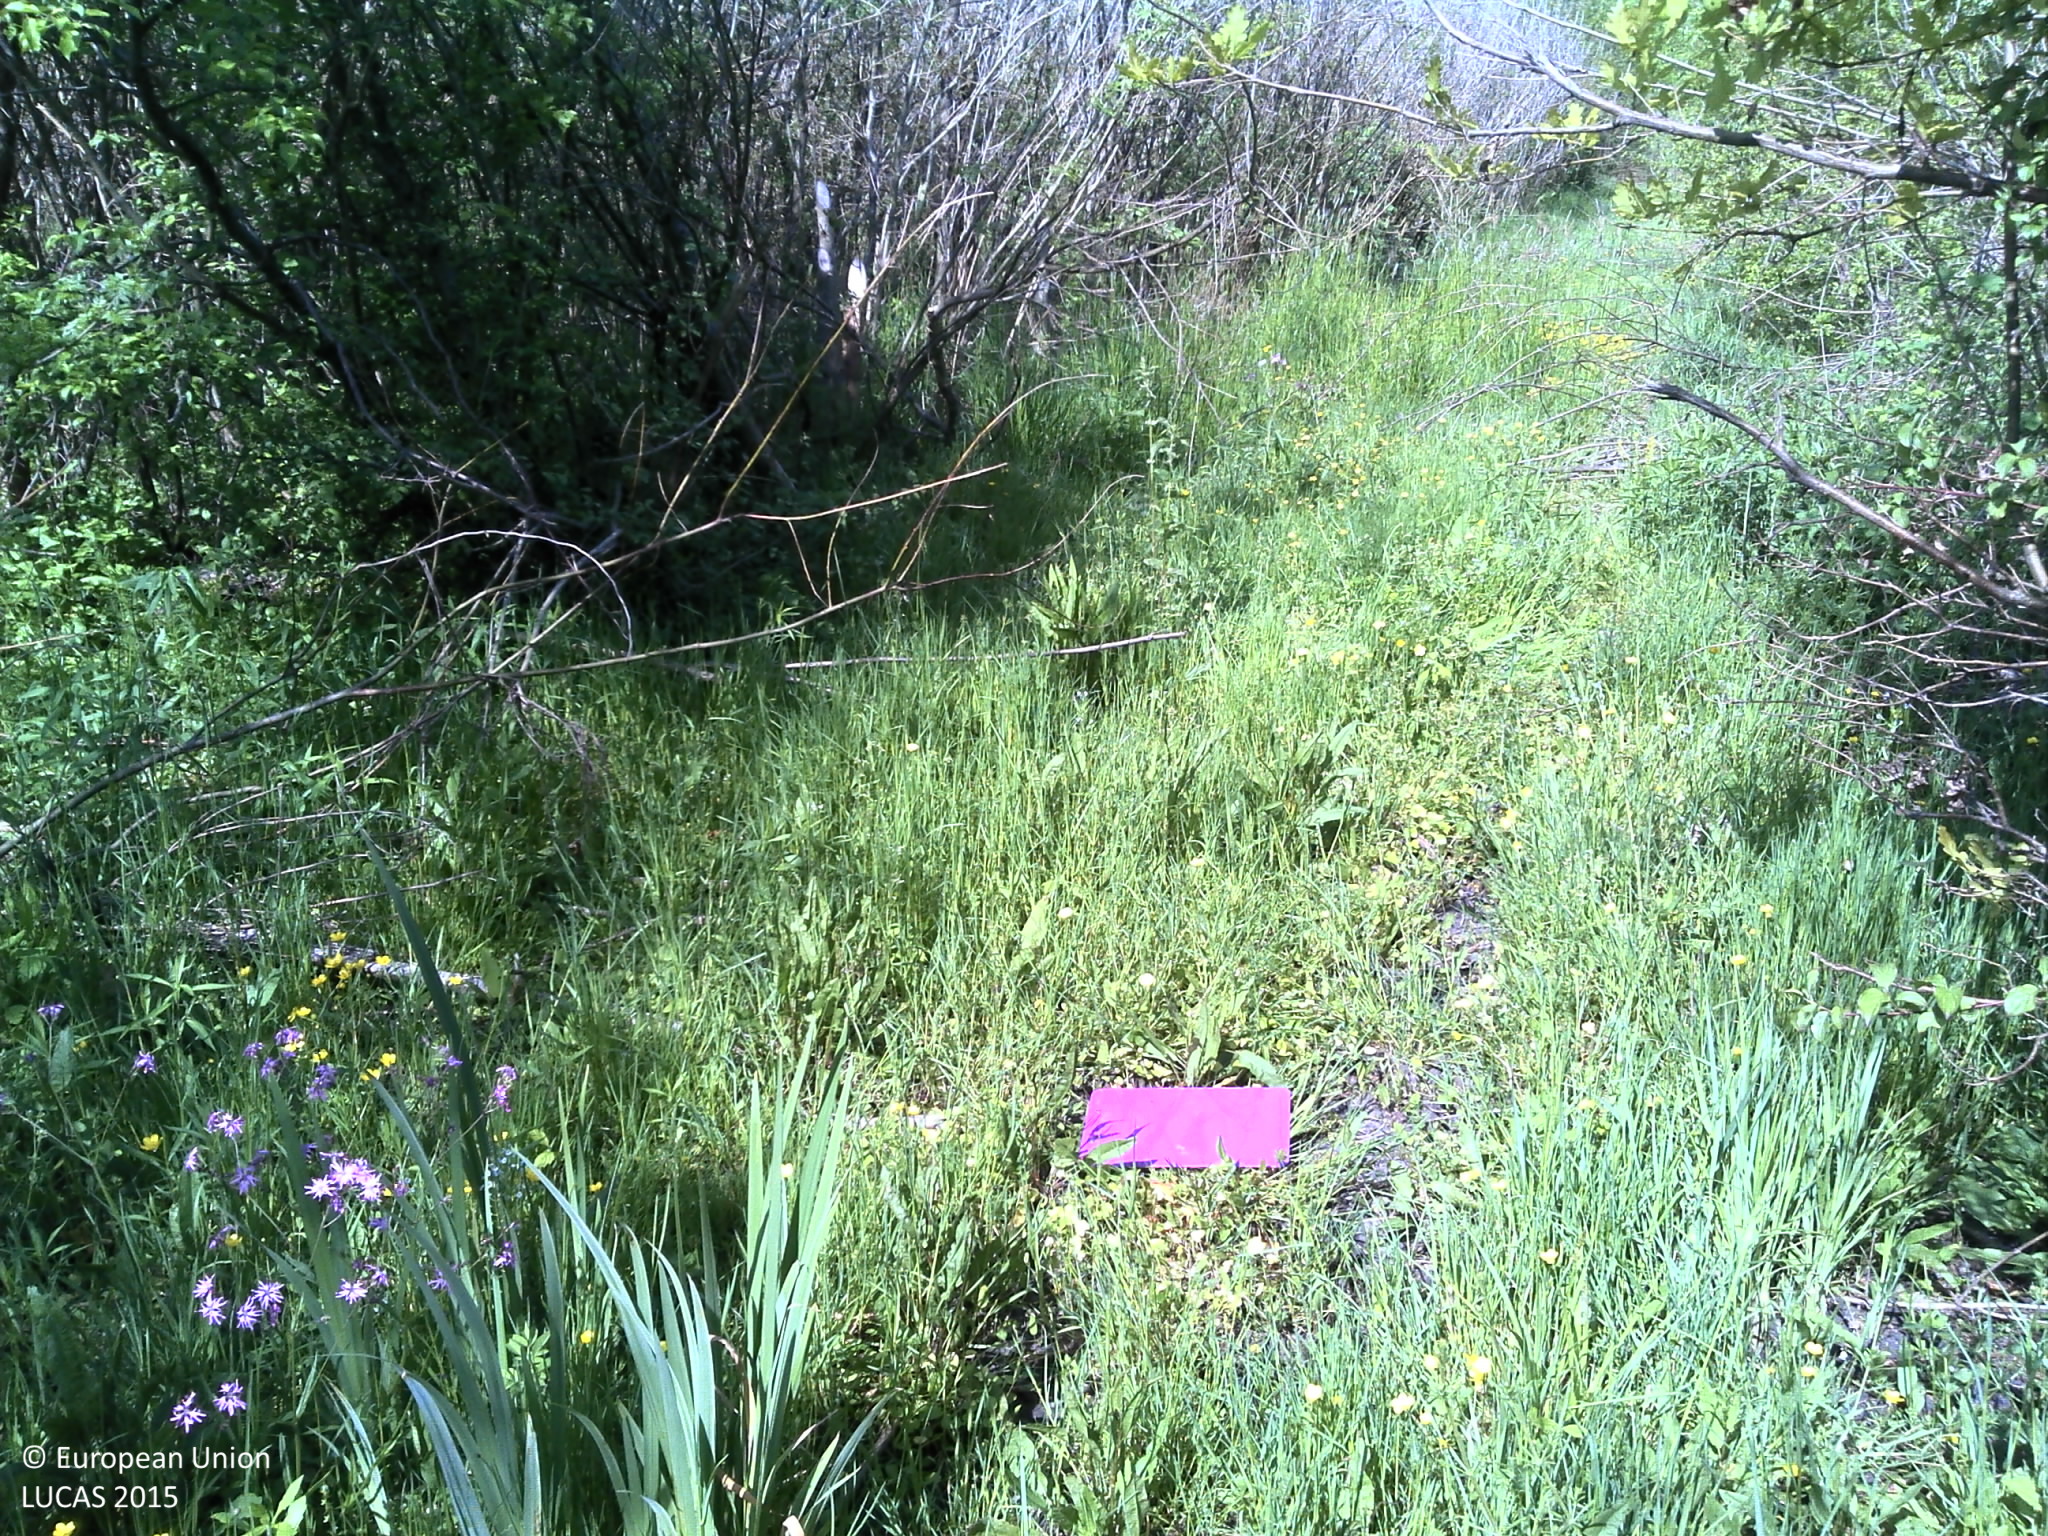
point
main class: Woodland
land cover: Broadleaved woodland
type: mesophytic deciduous forest
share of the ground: > 75 %
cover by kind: broadleaved forest trees 80 %, herbaceous plants 20 %
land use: Forestry
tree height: > 5 m
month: May
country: HR
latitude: 45.2177
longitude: 18.4732
